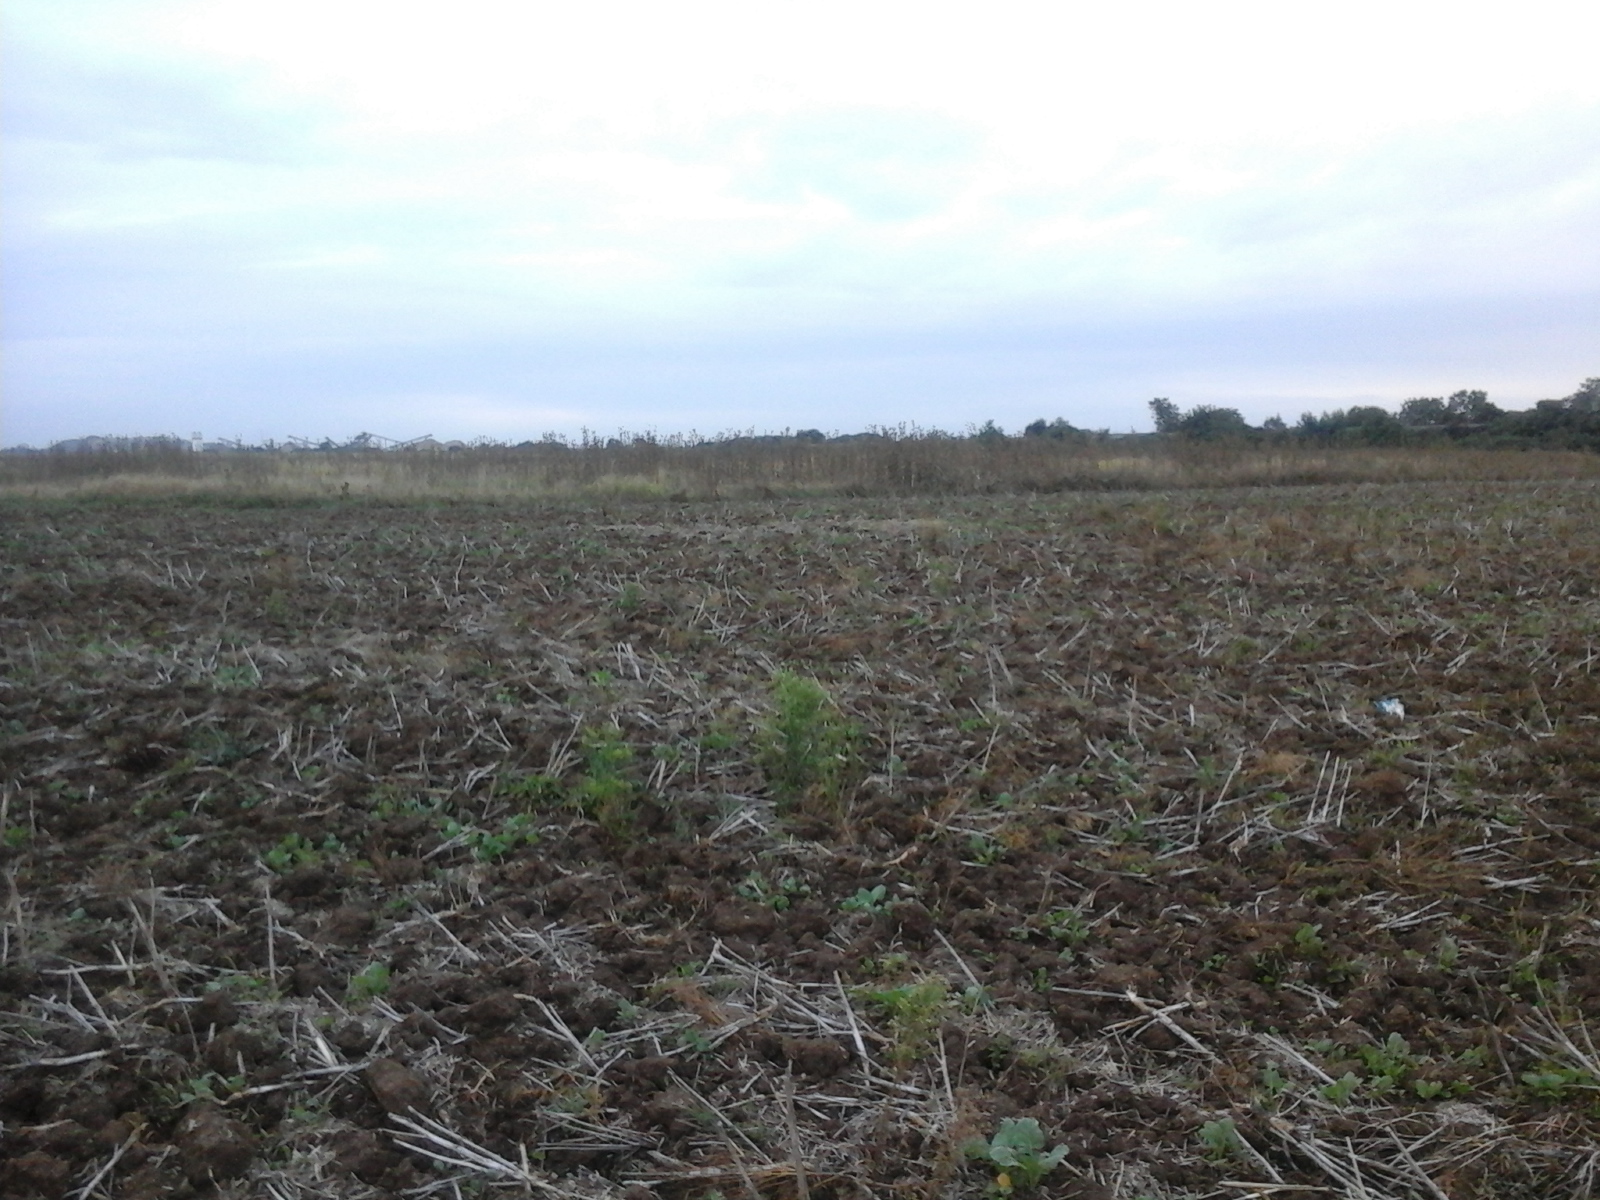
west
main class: Cropland
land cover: Rape and turnip rape
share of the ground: < 10 %
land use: Agriculture (excluding fallow land and kitchen gardens)
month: September
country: RO
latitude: 47.1221
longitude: 21.8960
